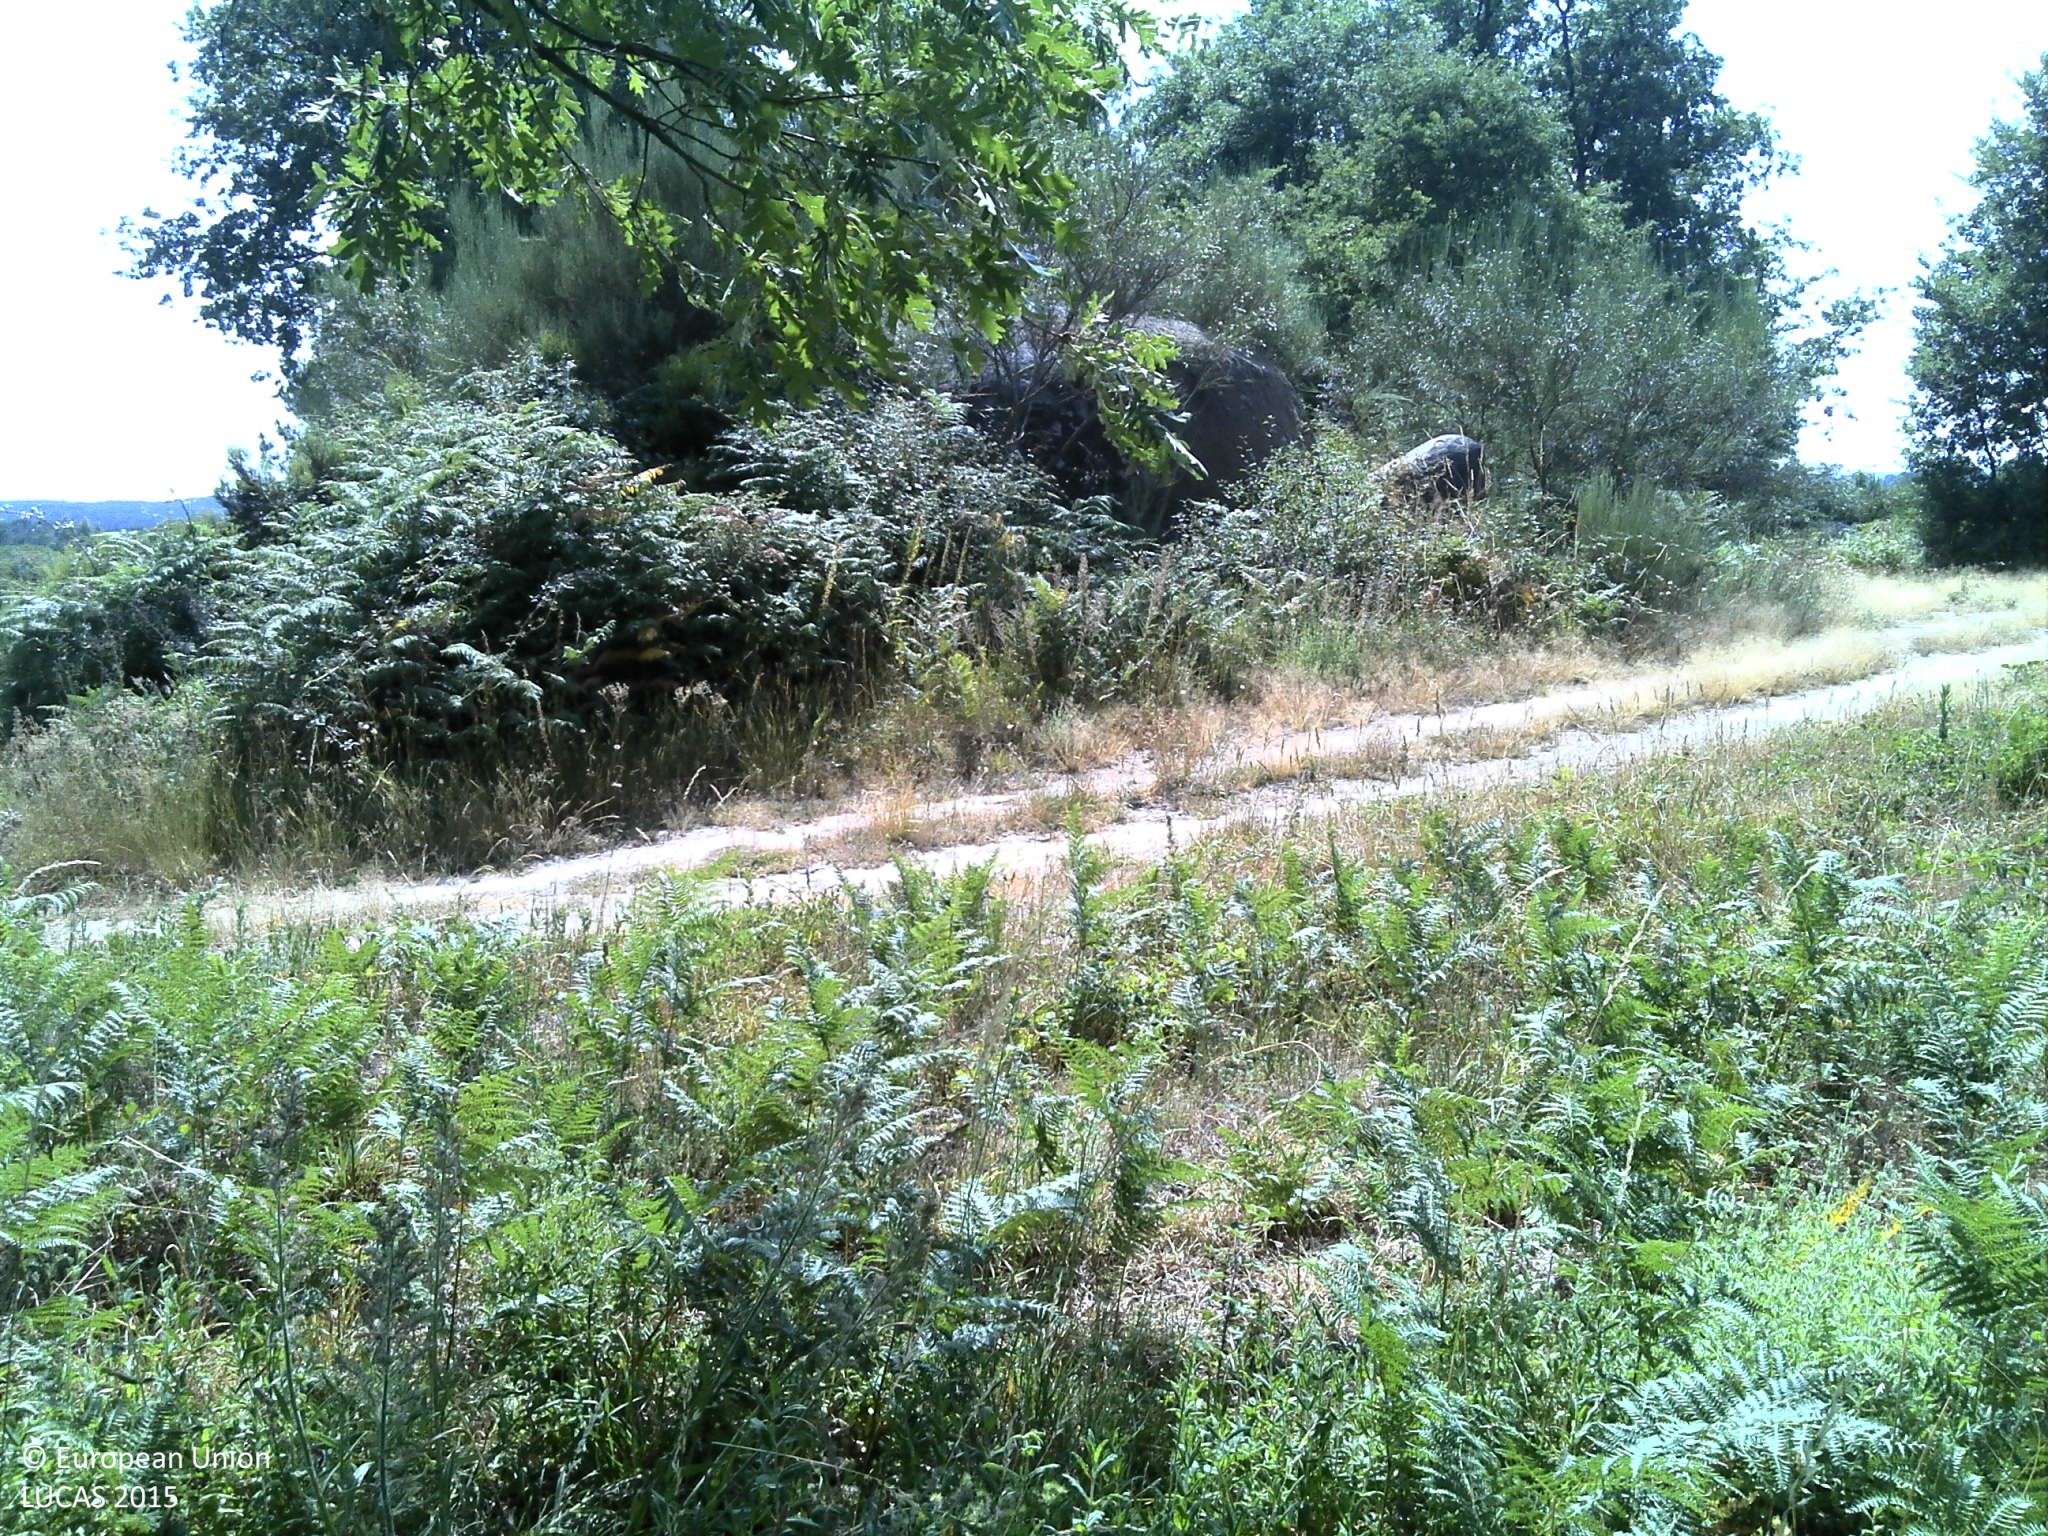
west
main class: Shrubland
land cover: Shrubland with sparse tree cover
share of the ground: 50 - 75 %
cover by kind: shrubs 55 %, unconsolidated bare surface 30 %, herbaceous plants 10 %, broadleaved forest trees 5 %
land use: Forestry
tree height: > 5 m
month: July
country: PT
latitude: 40.8948
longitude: -7.6042
